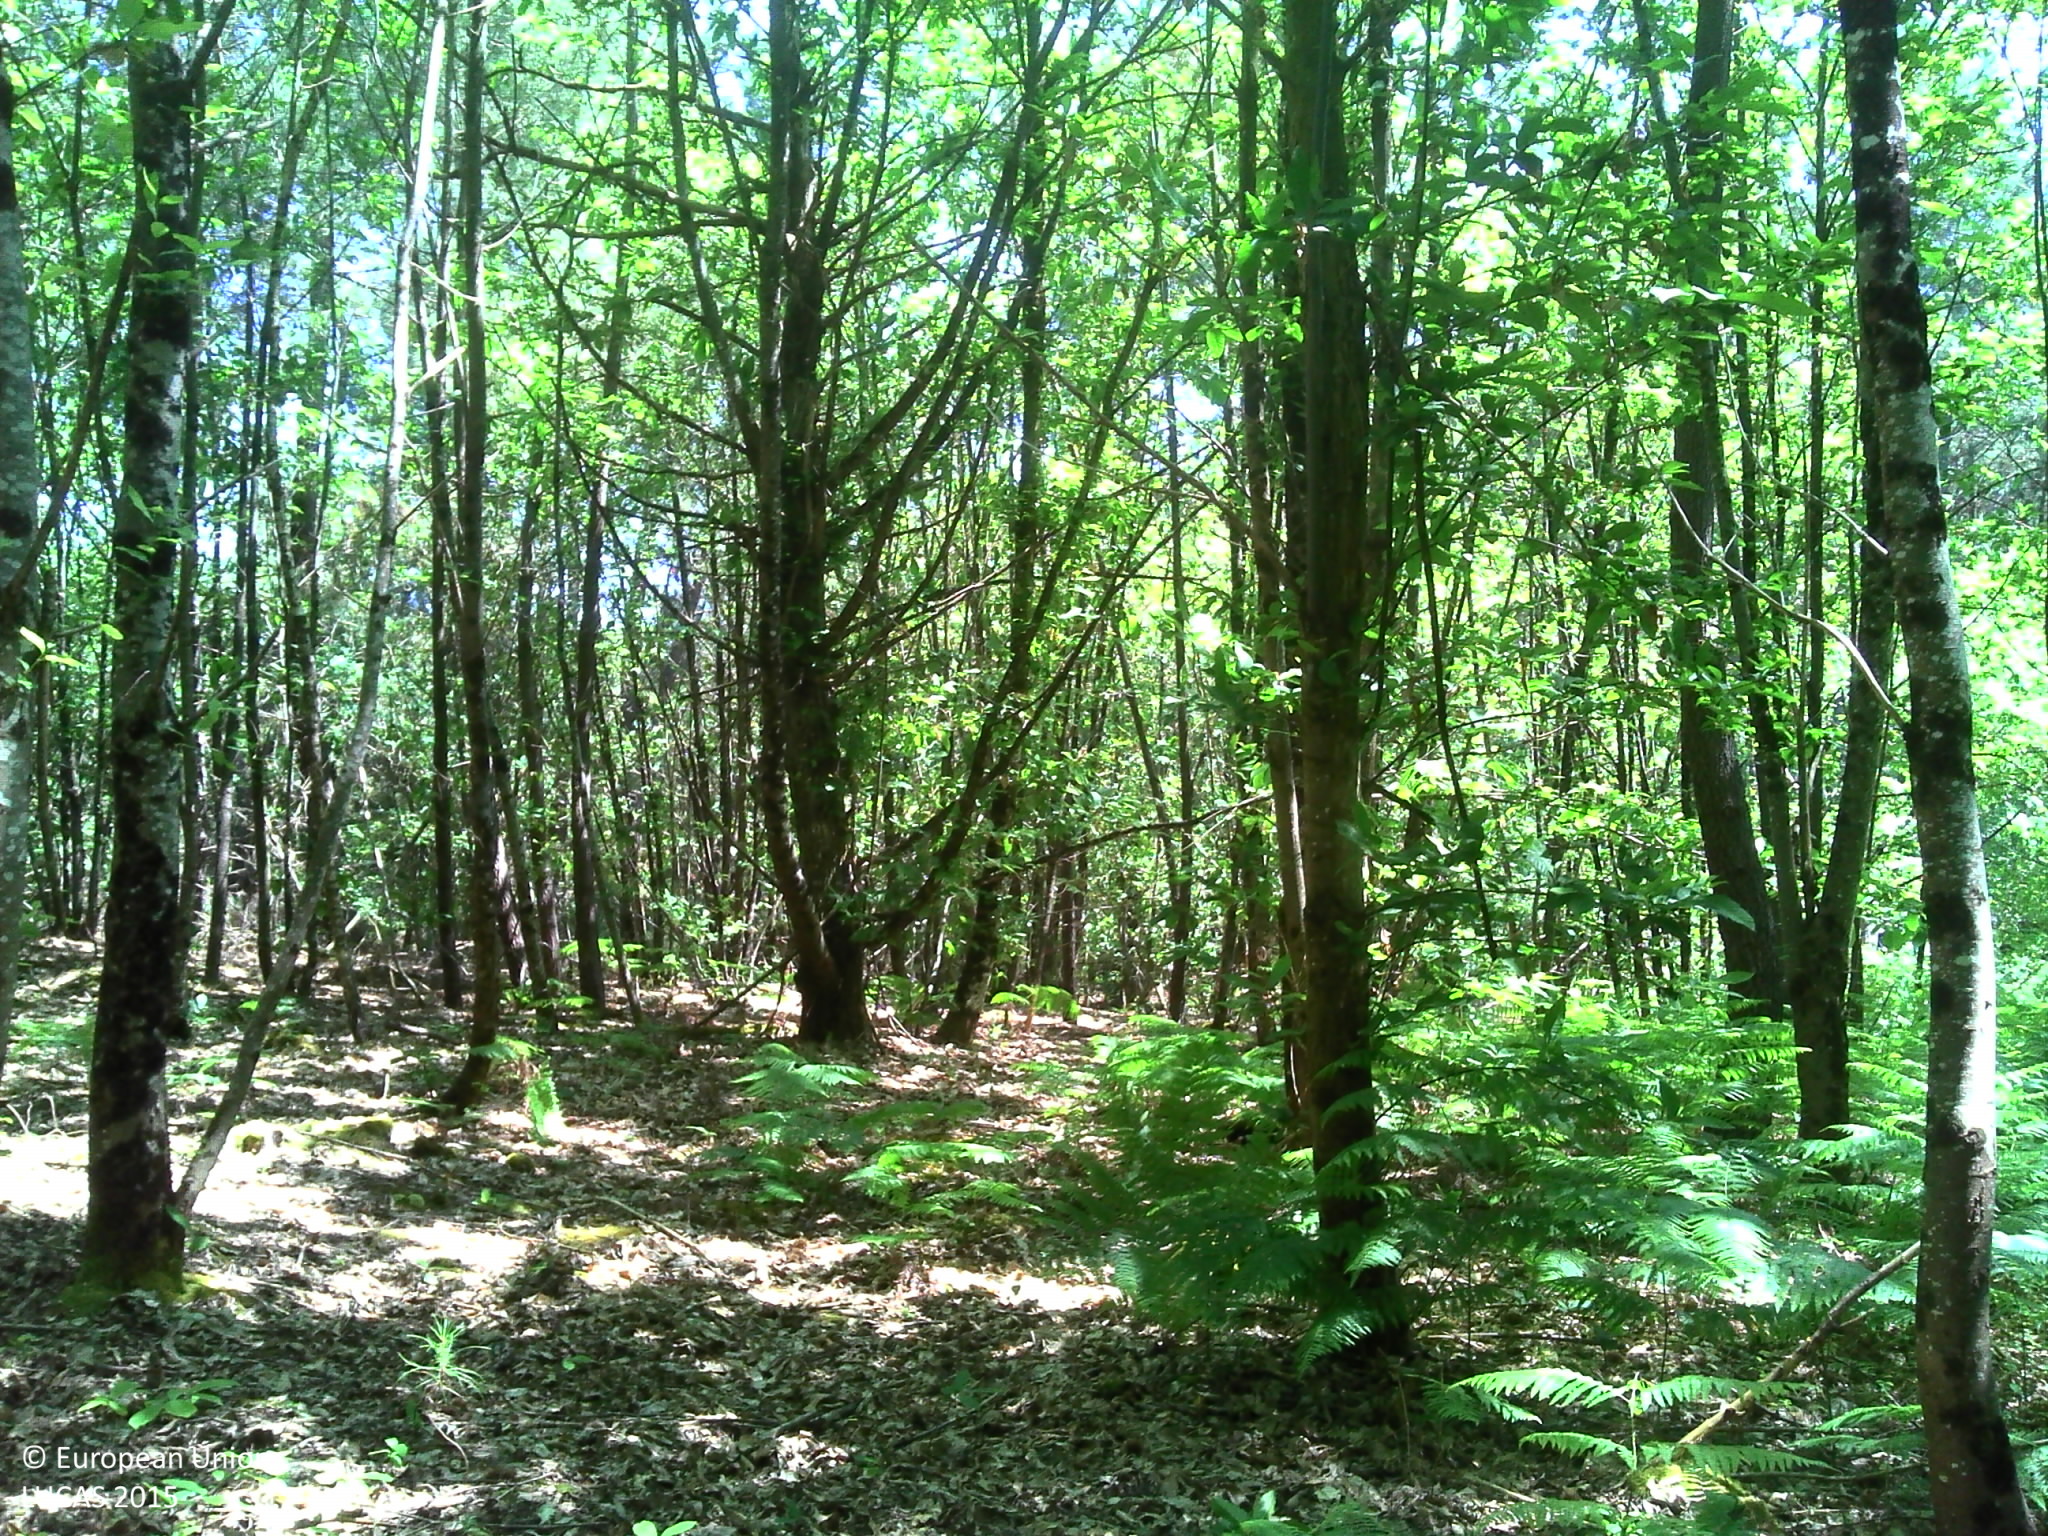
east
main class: Woodland
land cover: Broadleaved woodland
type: mesophytic deciduous forest
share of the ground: > 75 %
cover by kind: broadleaved forest trees 65 %, unconsolidated bare surface 15 %, herbaceous plants 10 %, lichens and mosses 10 %
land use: Forestry
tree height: > 5 m
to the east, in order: Broadleaved woodland; Grass margins; Tracks; Grass margins; Broadleaved woodland; Grass margins; Ditches and canals; Grass margins; Paved roads, cycling and walking lanes; Grass margins; Ditches and canals; Broadleaved woodland; Sunflower
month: June
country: FR
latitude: 47.3788
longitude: 0.1081
